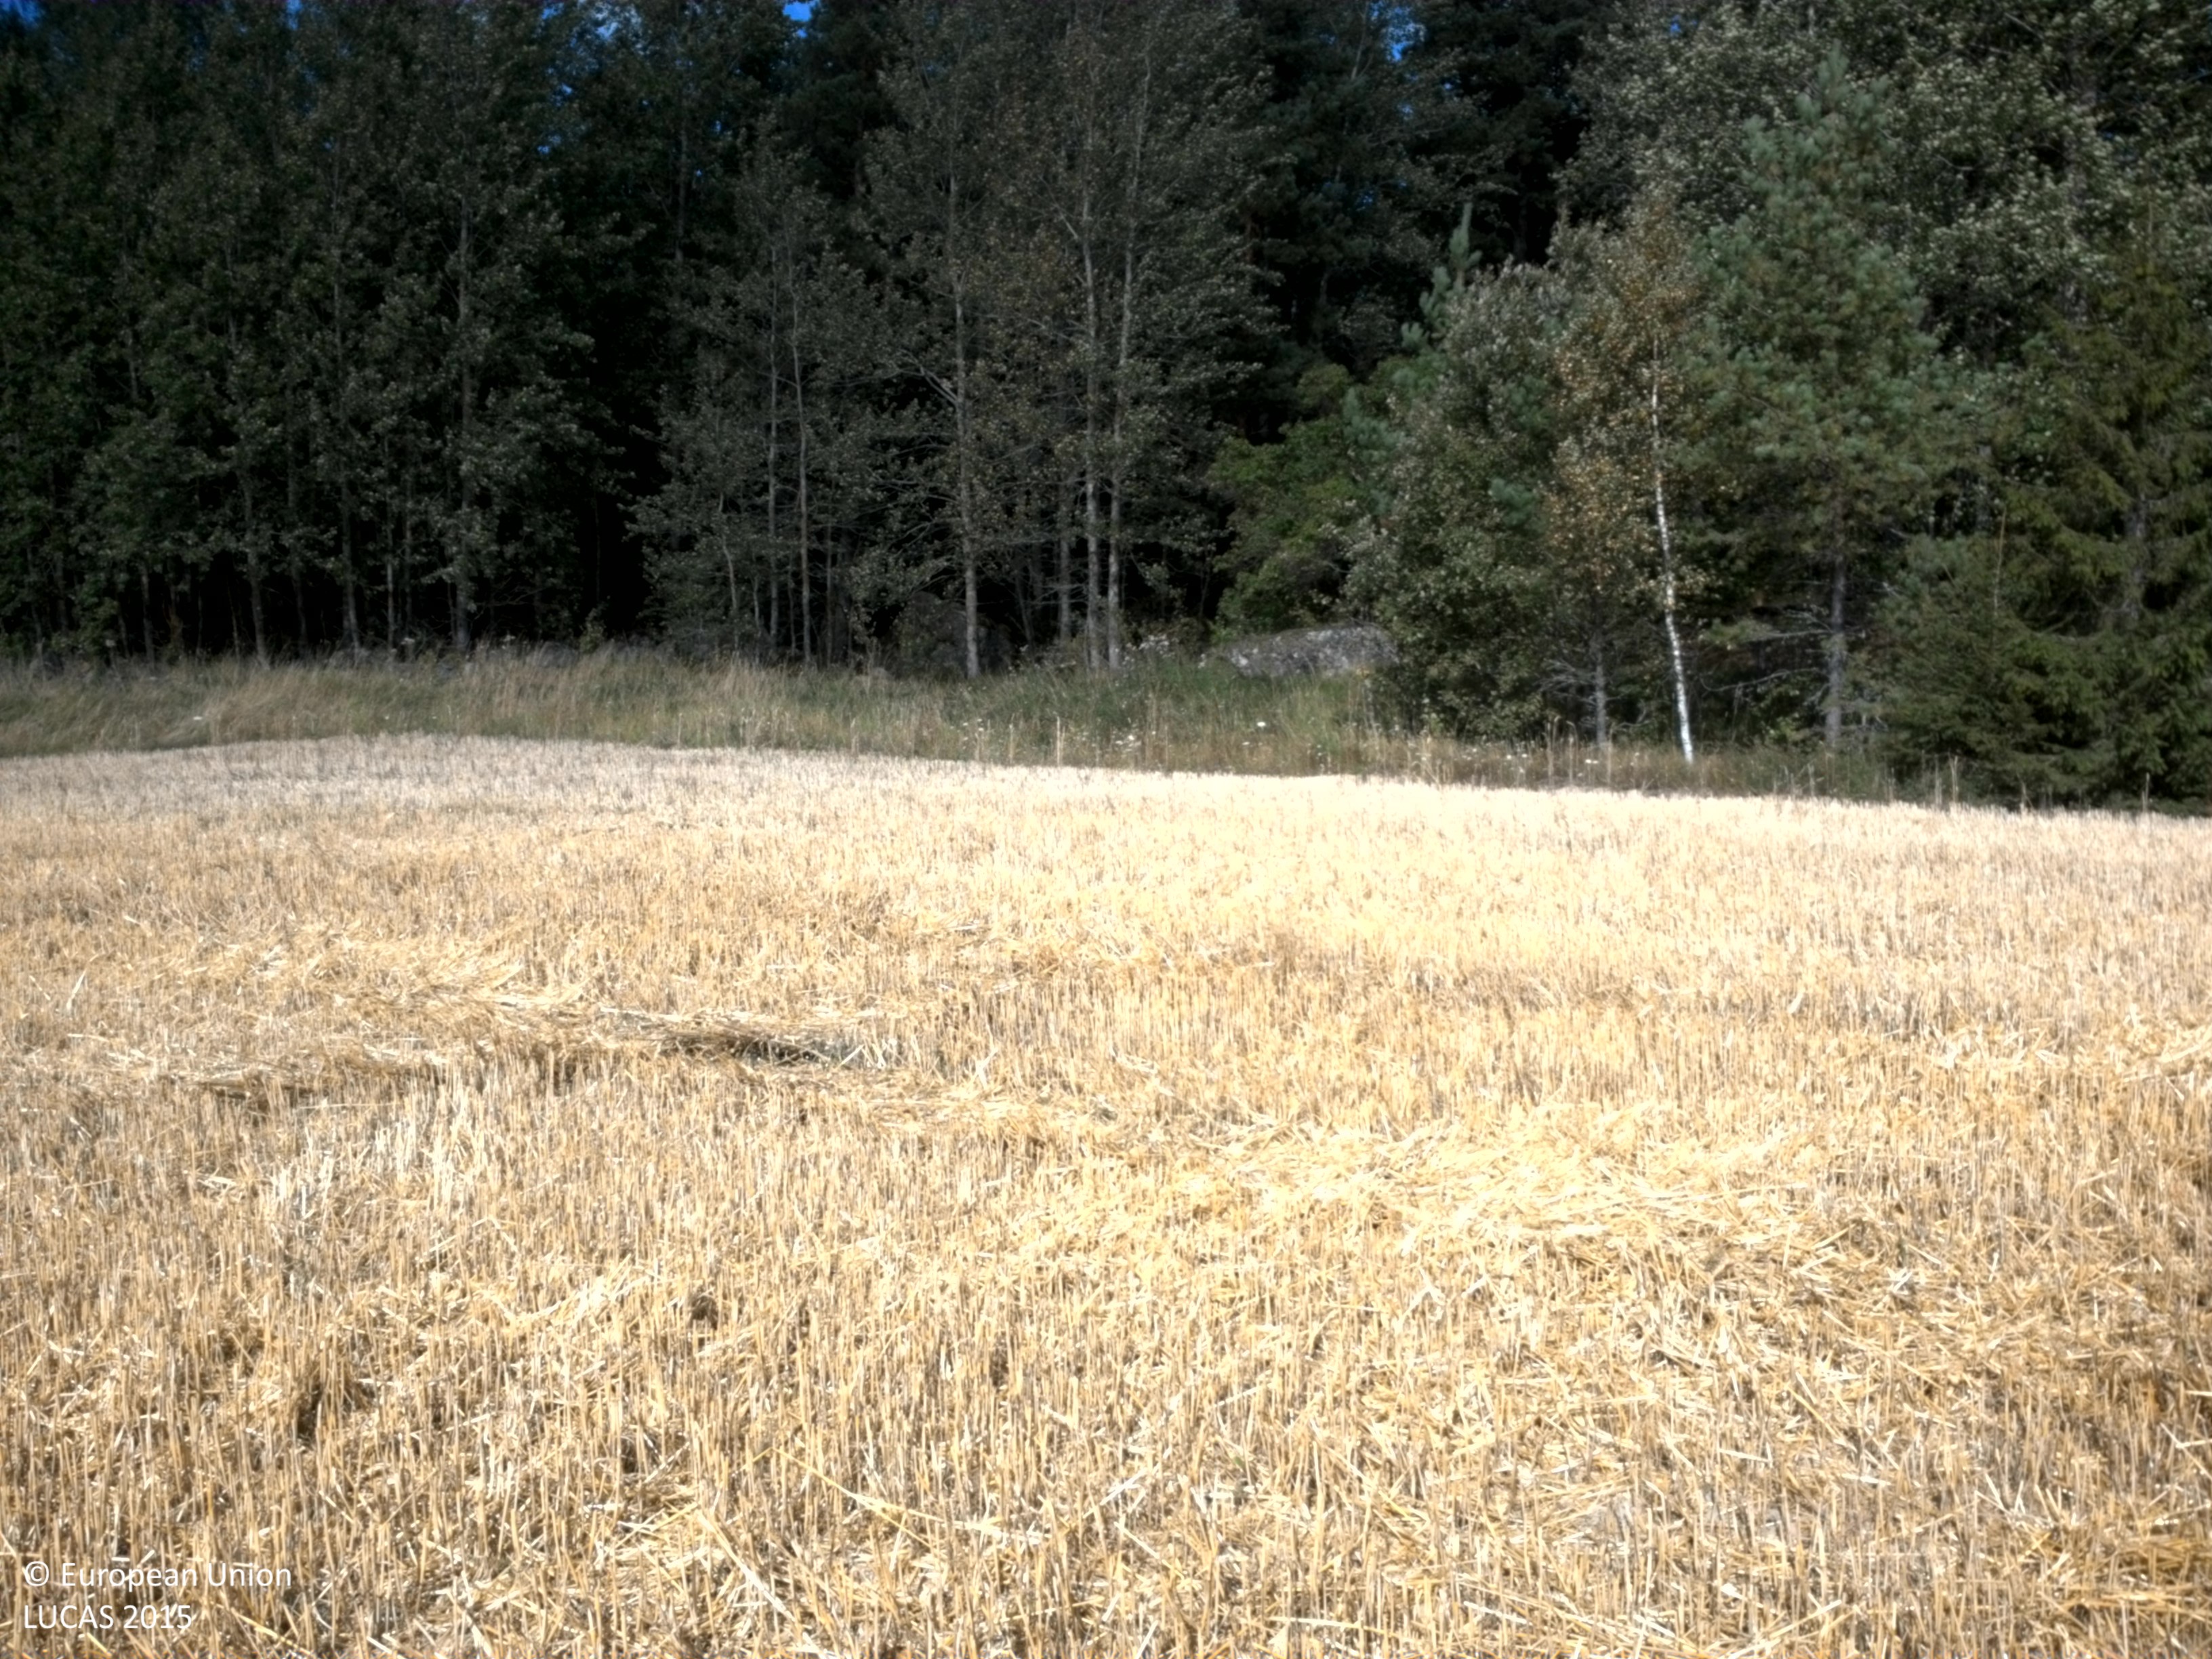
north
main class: Cropland
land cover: Common wheat
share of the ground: > 75 %
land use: Agriculture (excluding fallow land and kitchen gardens)
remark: Harvested field
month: August
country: SE
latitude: 59.6541
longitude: 17.1805
